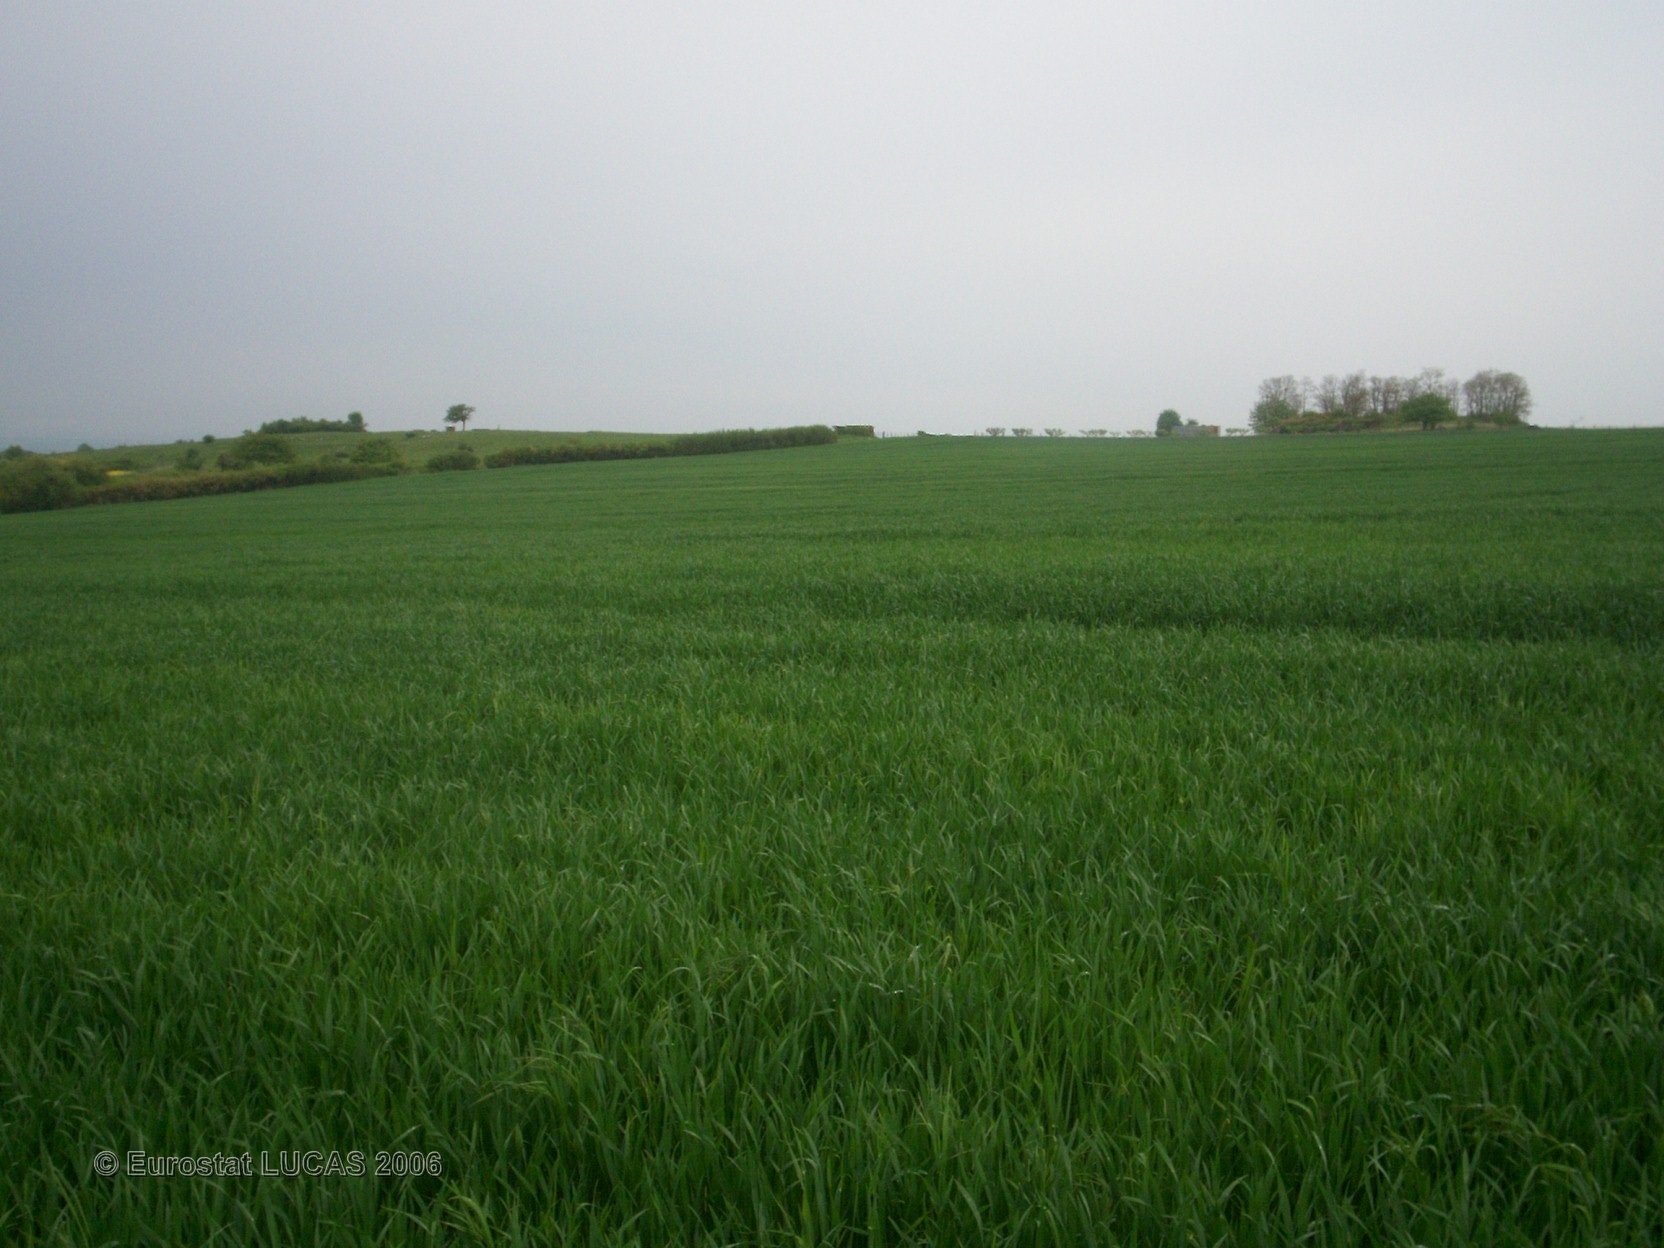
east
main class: Cropland
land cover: Common wheat
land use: Agriculture (excluding fallow land and kitchen gardens)
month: May
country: FR
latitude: 46.0599
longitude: 3.1610
